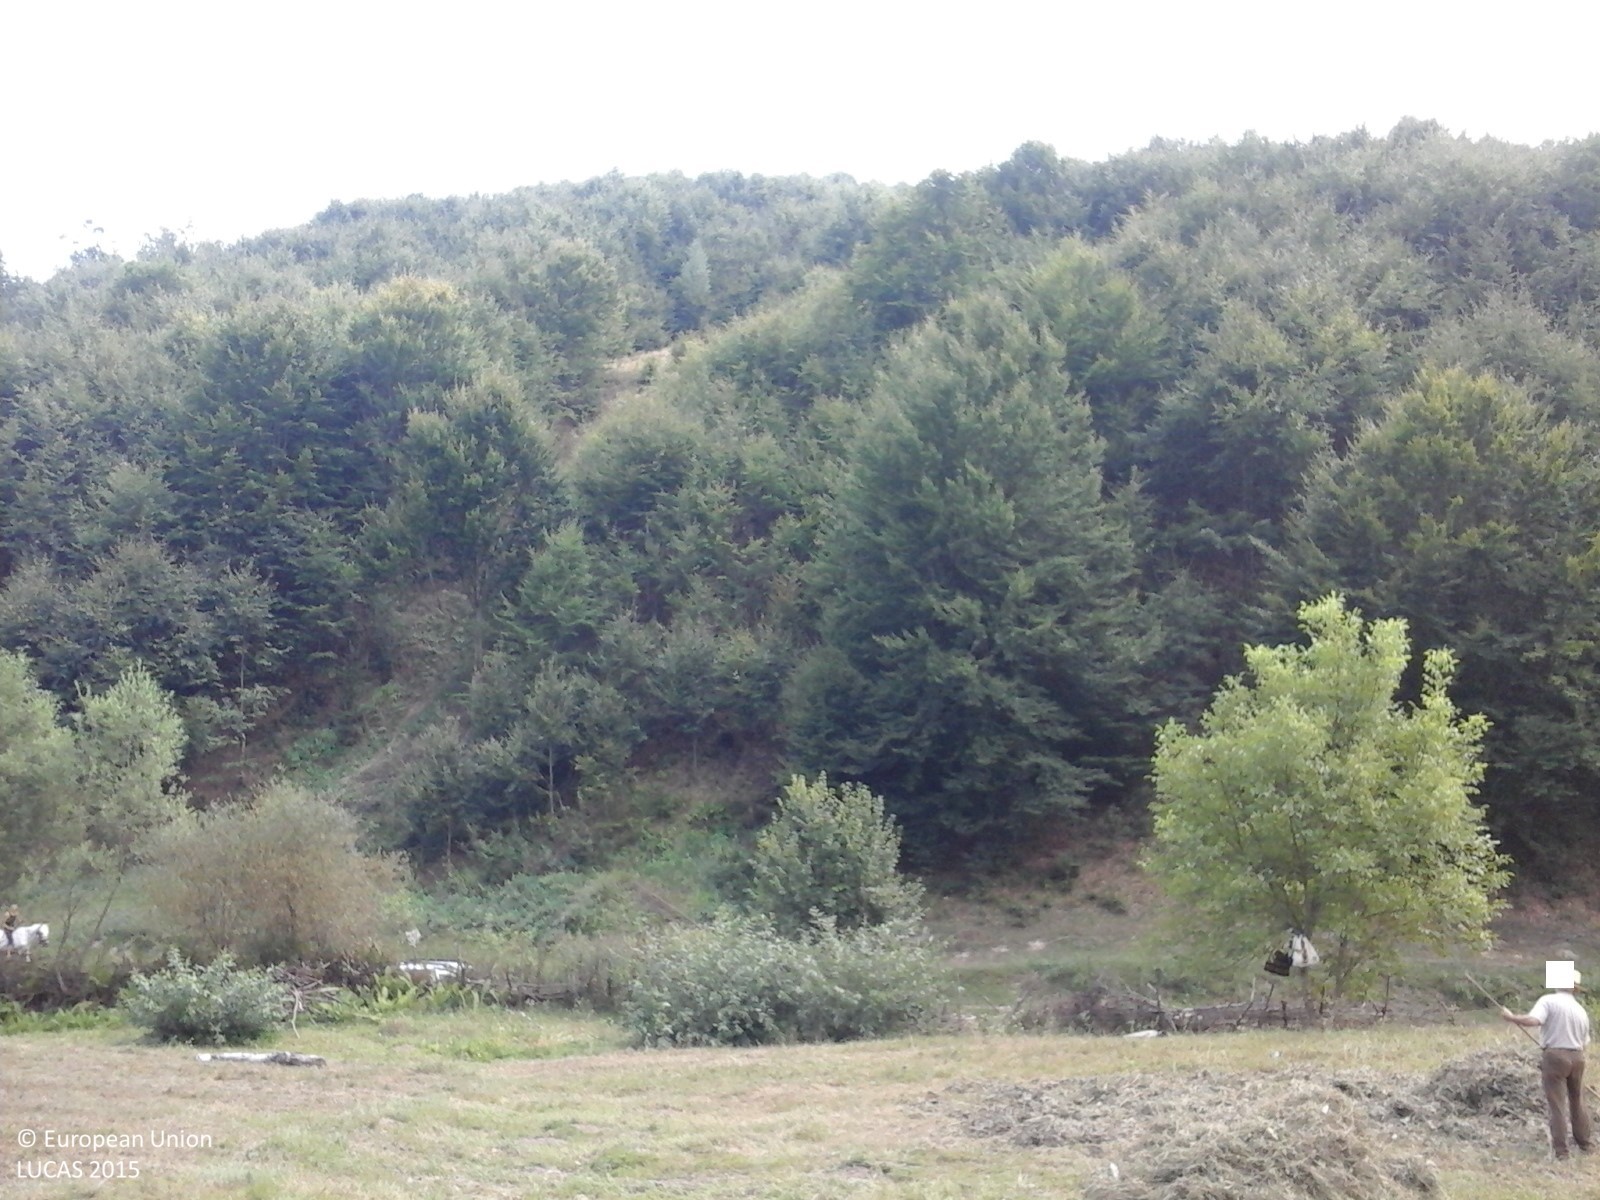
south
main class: Cropland
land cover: Potatoes
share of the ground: > 75 %
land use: Agriculture (excluding fallow land and kitchen gardens)
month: September
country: RO
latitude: 47.3835
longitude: 24.2475
